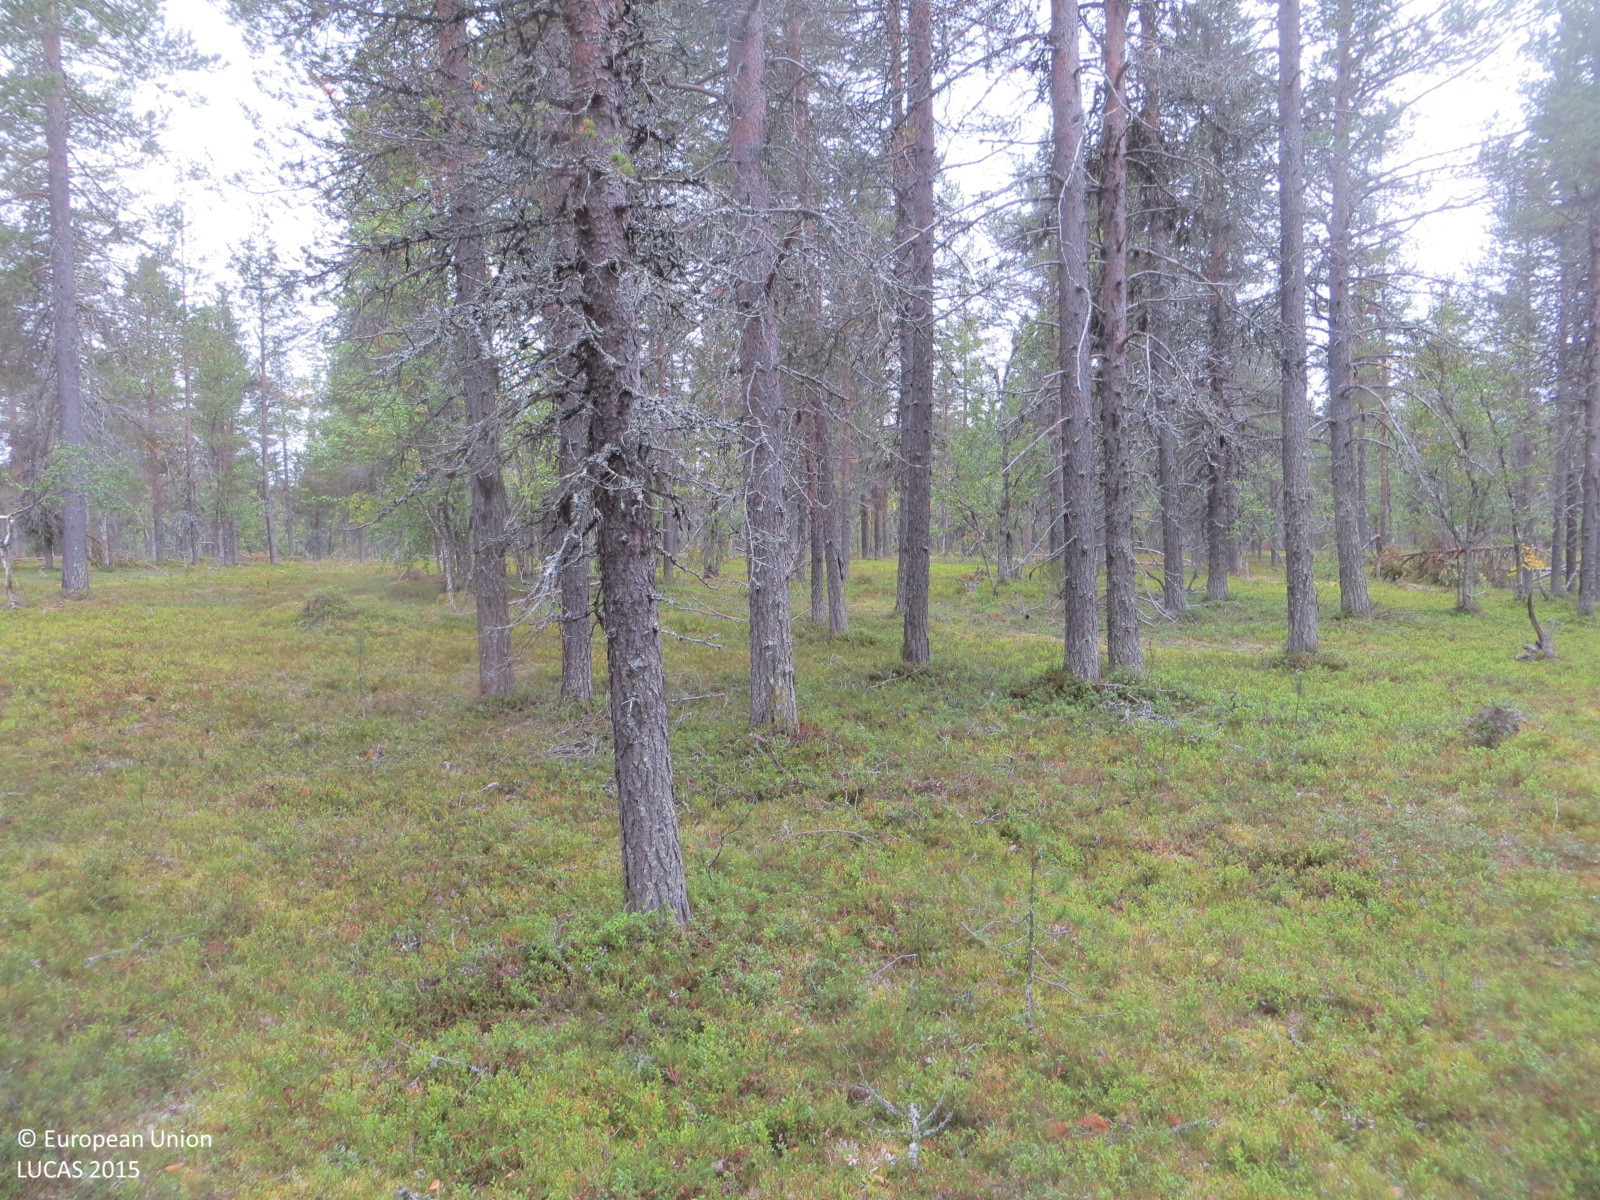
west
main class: Woodland
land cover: Pine dominated coniferous woodland
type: boreal forest
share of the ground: 50 - 75 %
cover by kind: coniferous forest trees 50 %, shrubs 50 %
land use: Forestry
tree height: > 5 m
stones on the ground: 25 - 50 %
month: August
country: FI
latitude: 68.1420
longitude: 25.6135
